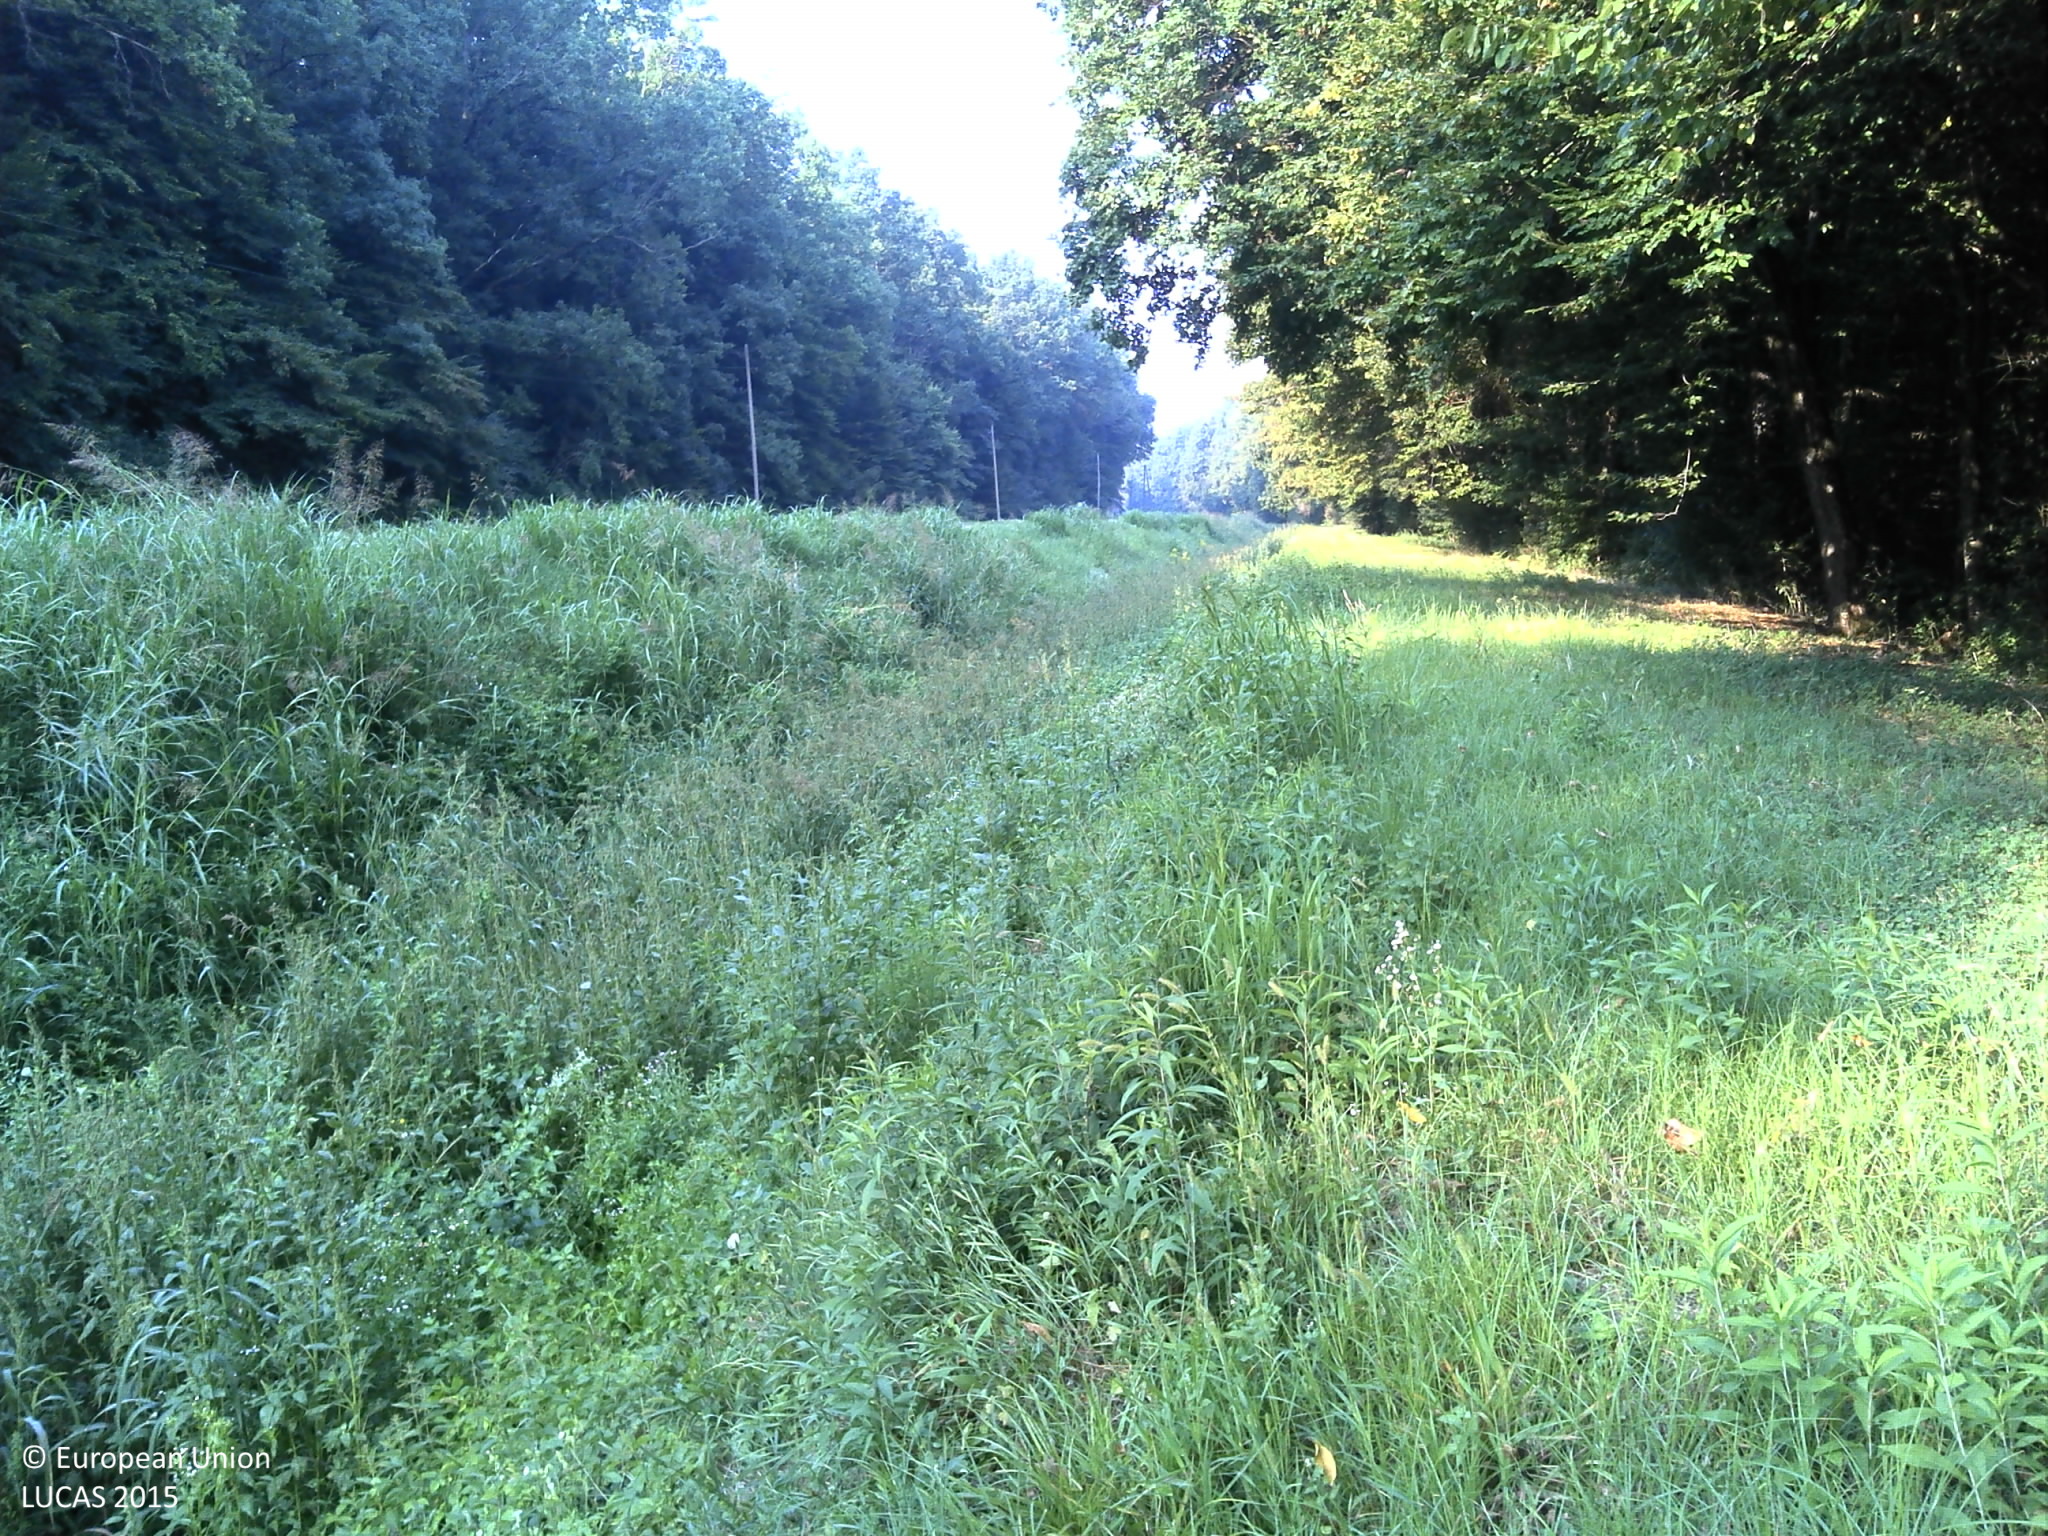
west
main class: Grassland
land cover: Spontaneously vegetated surfaces
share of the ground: > 75 %
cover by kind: herbaceous plants 100 %
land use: Road transport
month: August
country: HR
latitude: 45.9575
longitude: 17.2922
